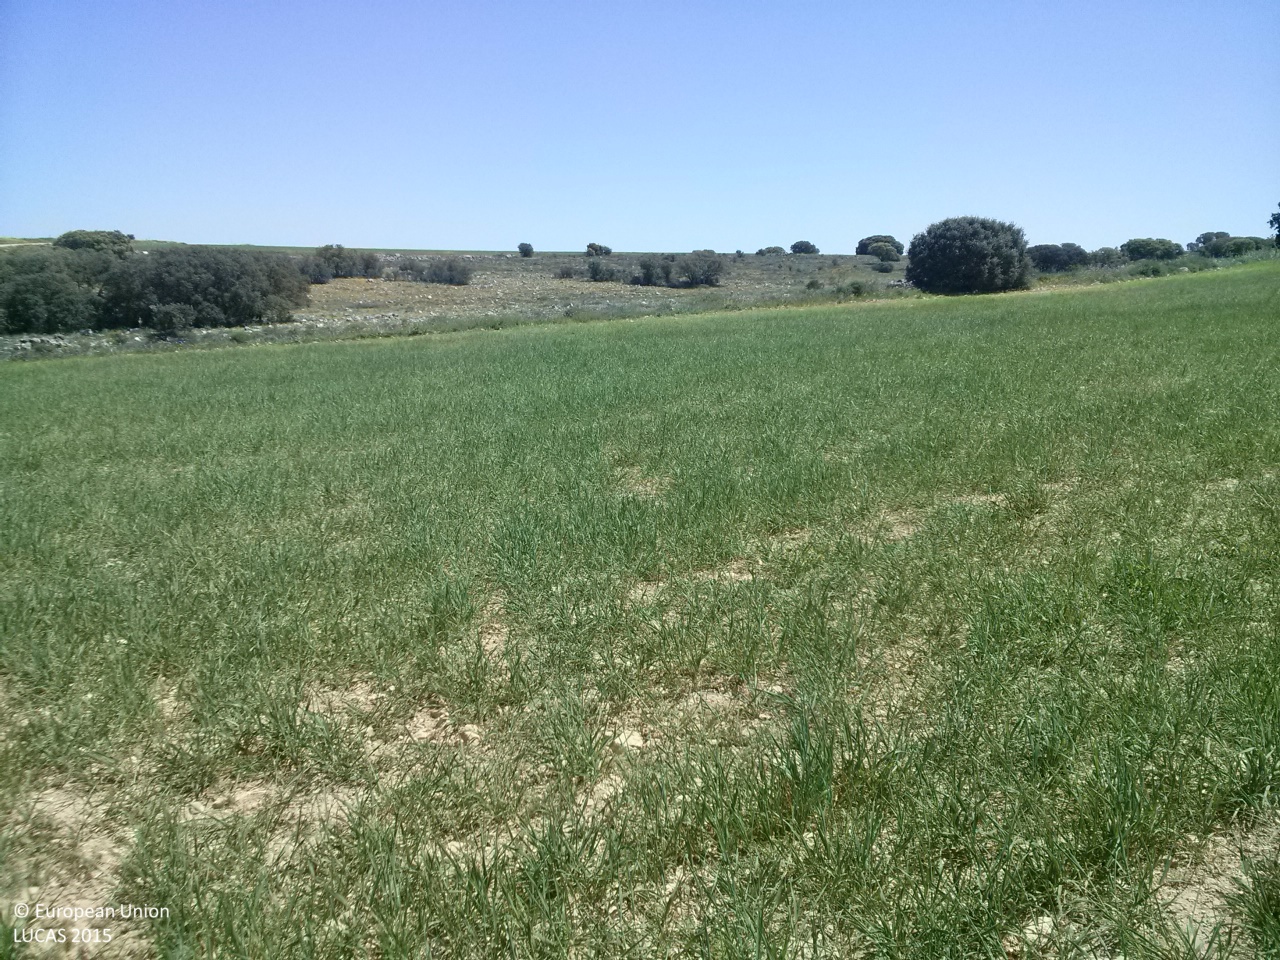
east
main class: Cropland
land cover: Barley
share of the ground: > 75 %
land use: Agriculture (excluding fallow land and kitchen gardens)
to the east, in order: Barley; Grass margins; Shrubland without tree cover; Grassland with sparse tree/shrub cover; Shrubland without tree cover; Single bushes/trees; Dry pulses
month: May
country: ES
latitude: 39.7785
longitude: -2.7563
